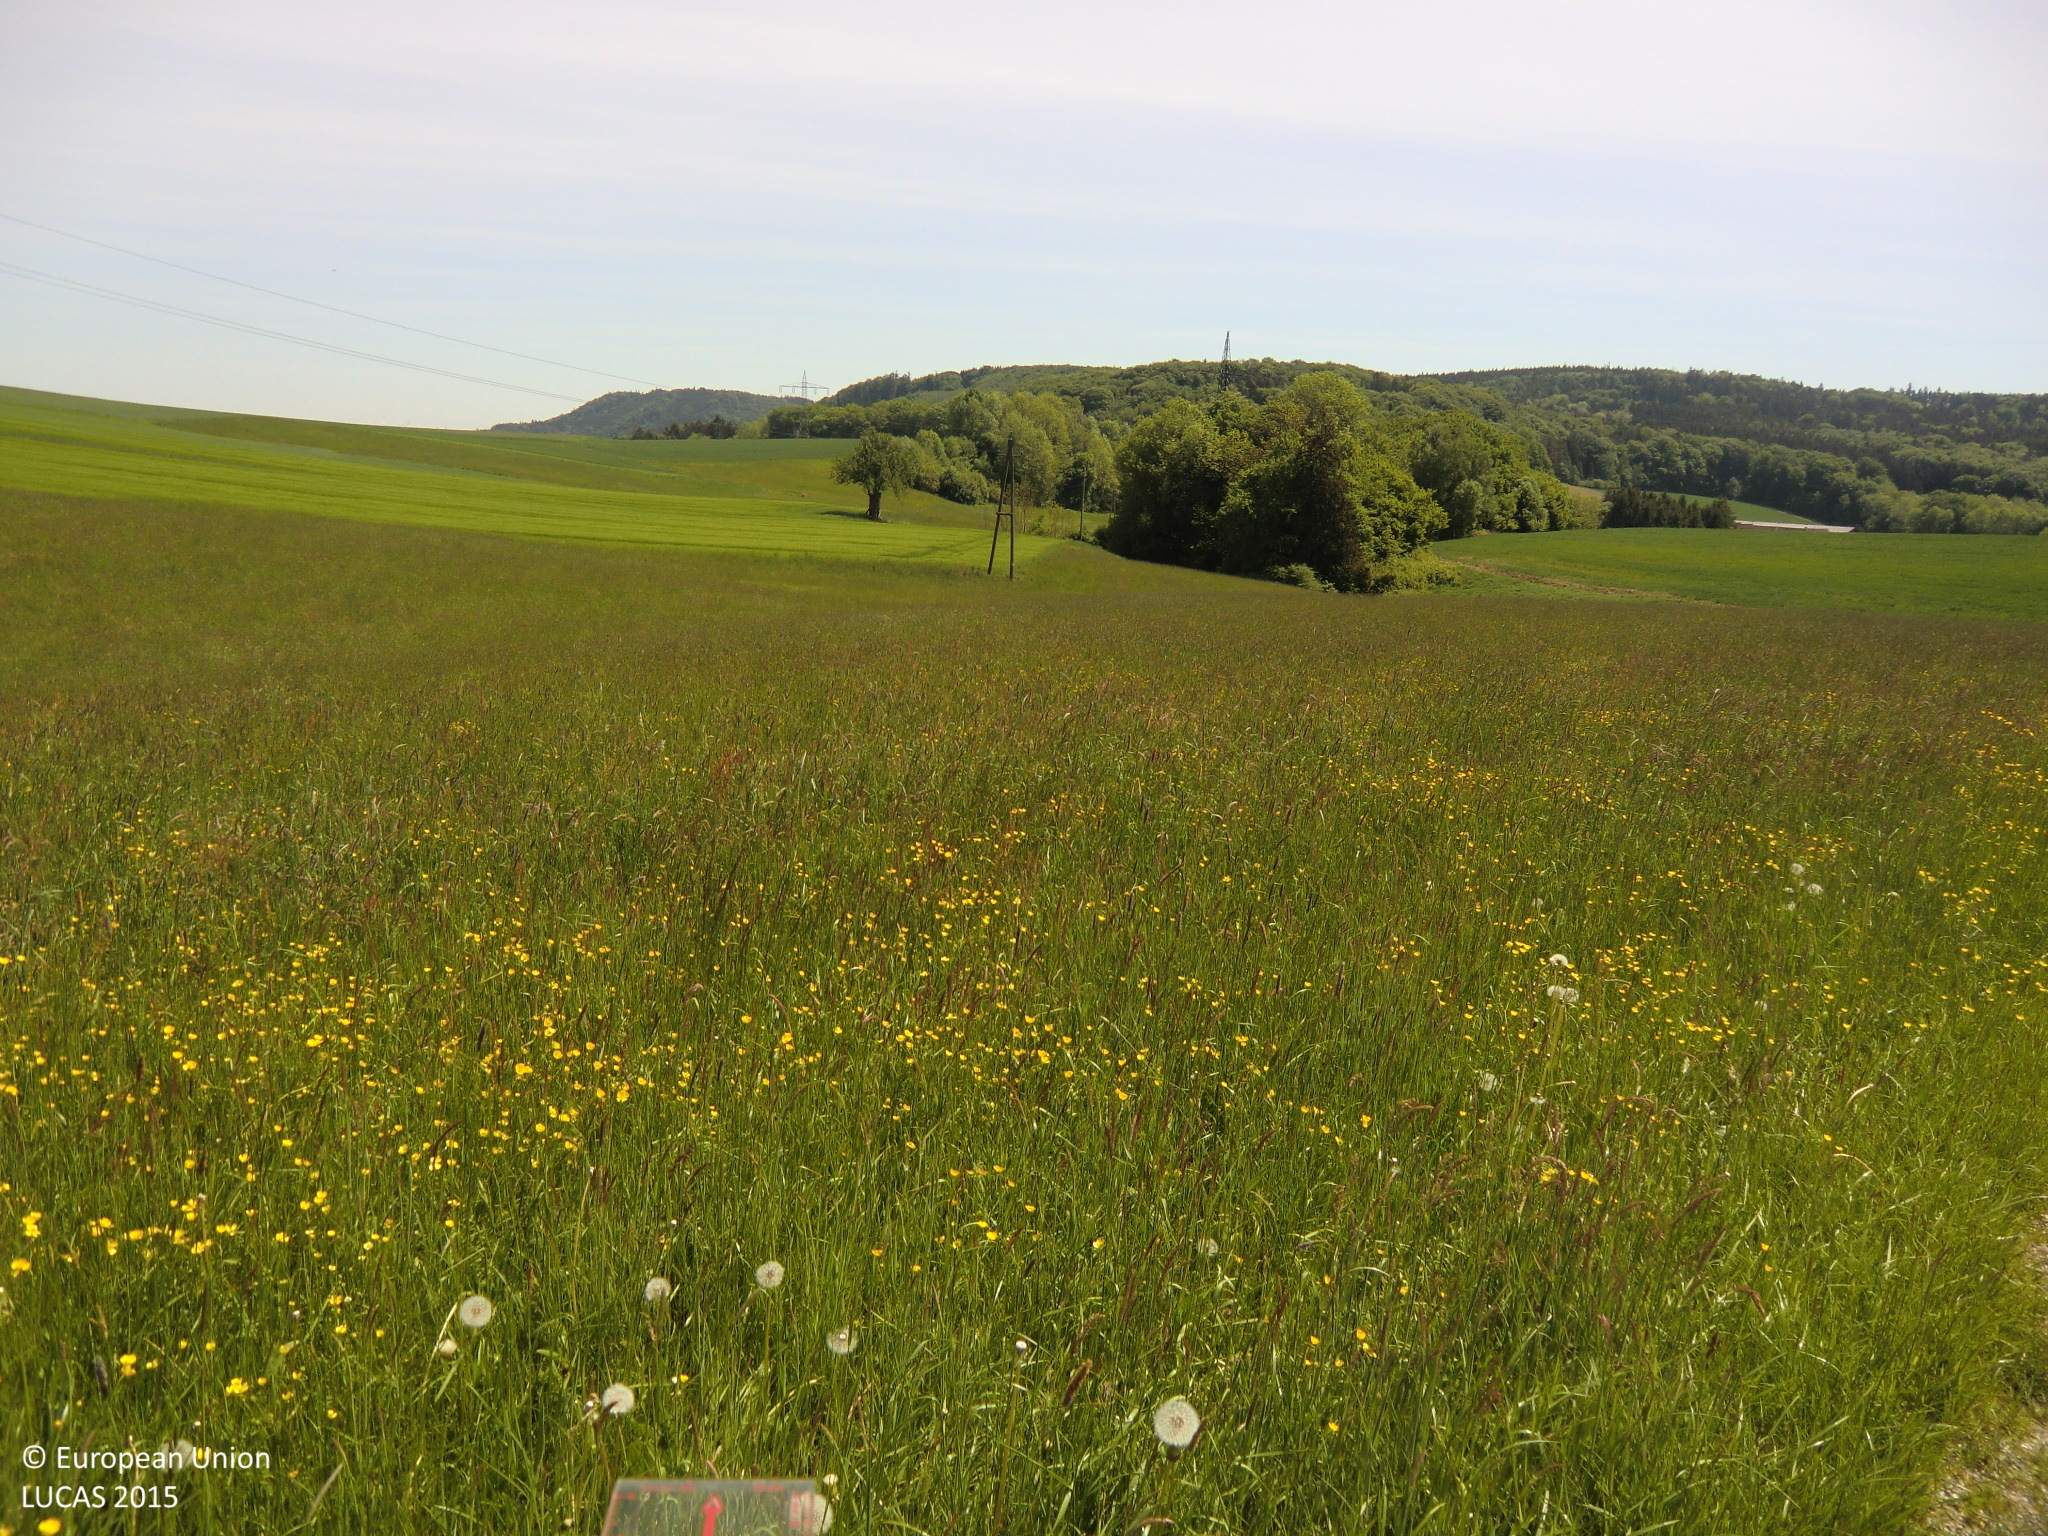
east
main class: Grassland
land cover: Grassland without tree/shrub cover
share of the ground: > 75 %
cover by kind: herbaceous plants 100 %
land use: Agriculture (excluding fallow land and kitchen gardens)
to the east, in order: Grassland without tree/shrub cover; Electric lines; Grassland without tree/shrub cover; Barley; Tracks; Barley; Grassland without tree/shrub cover
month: May
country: AT
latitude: 48.1663
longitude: 15.3398
